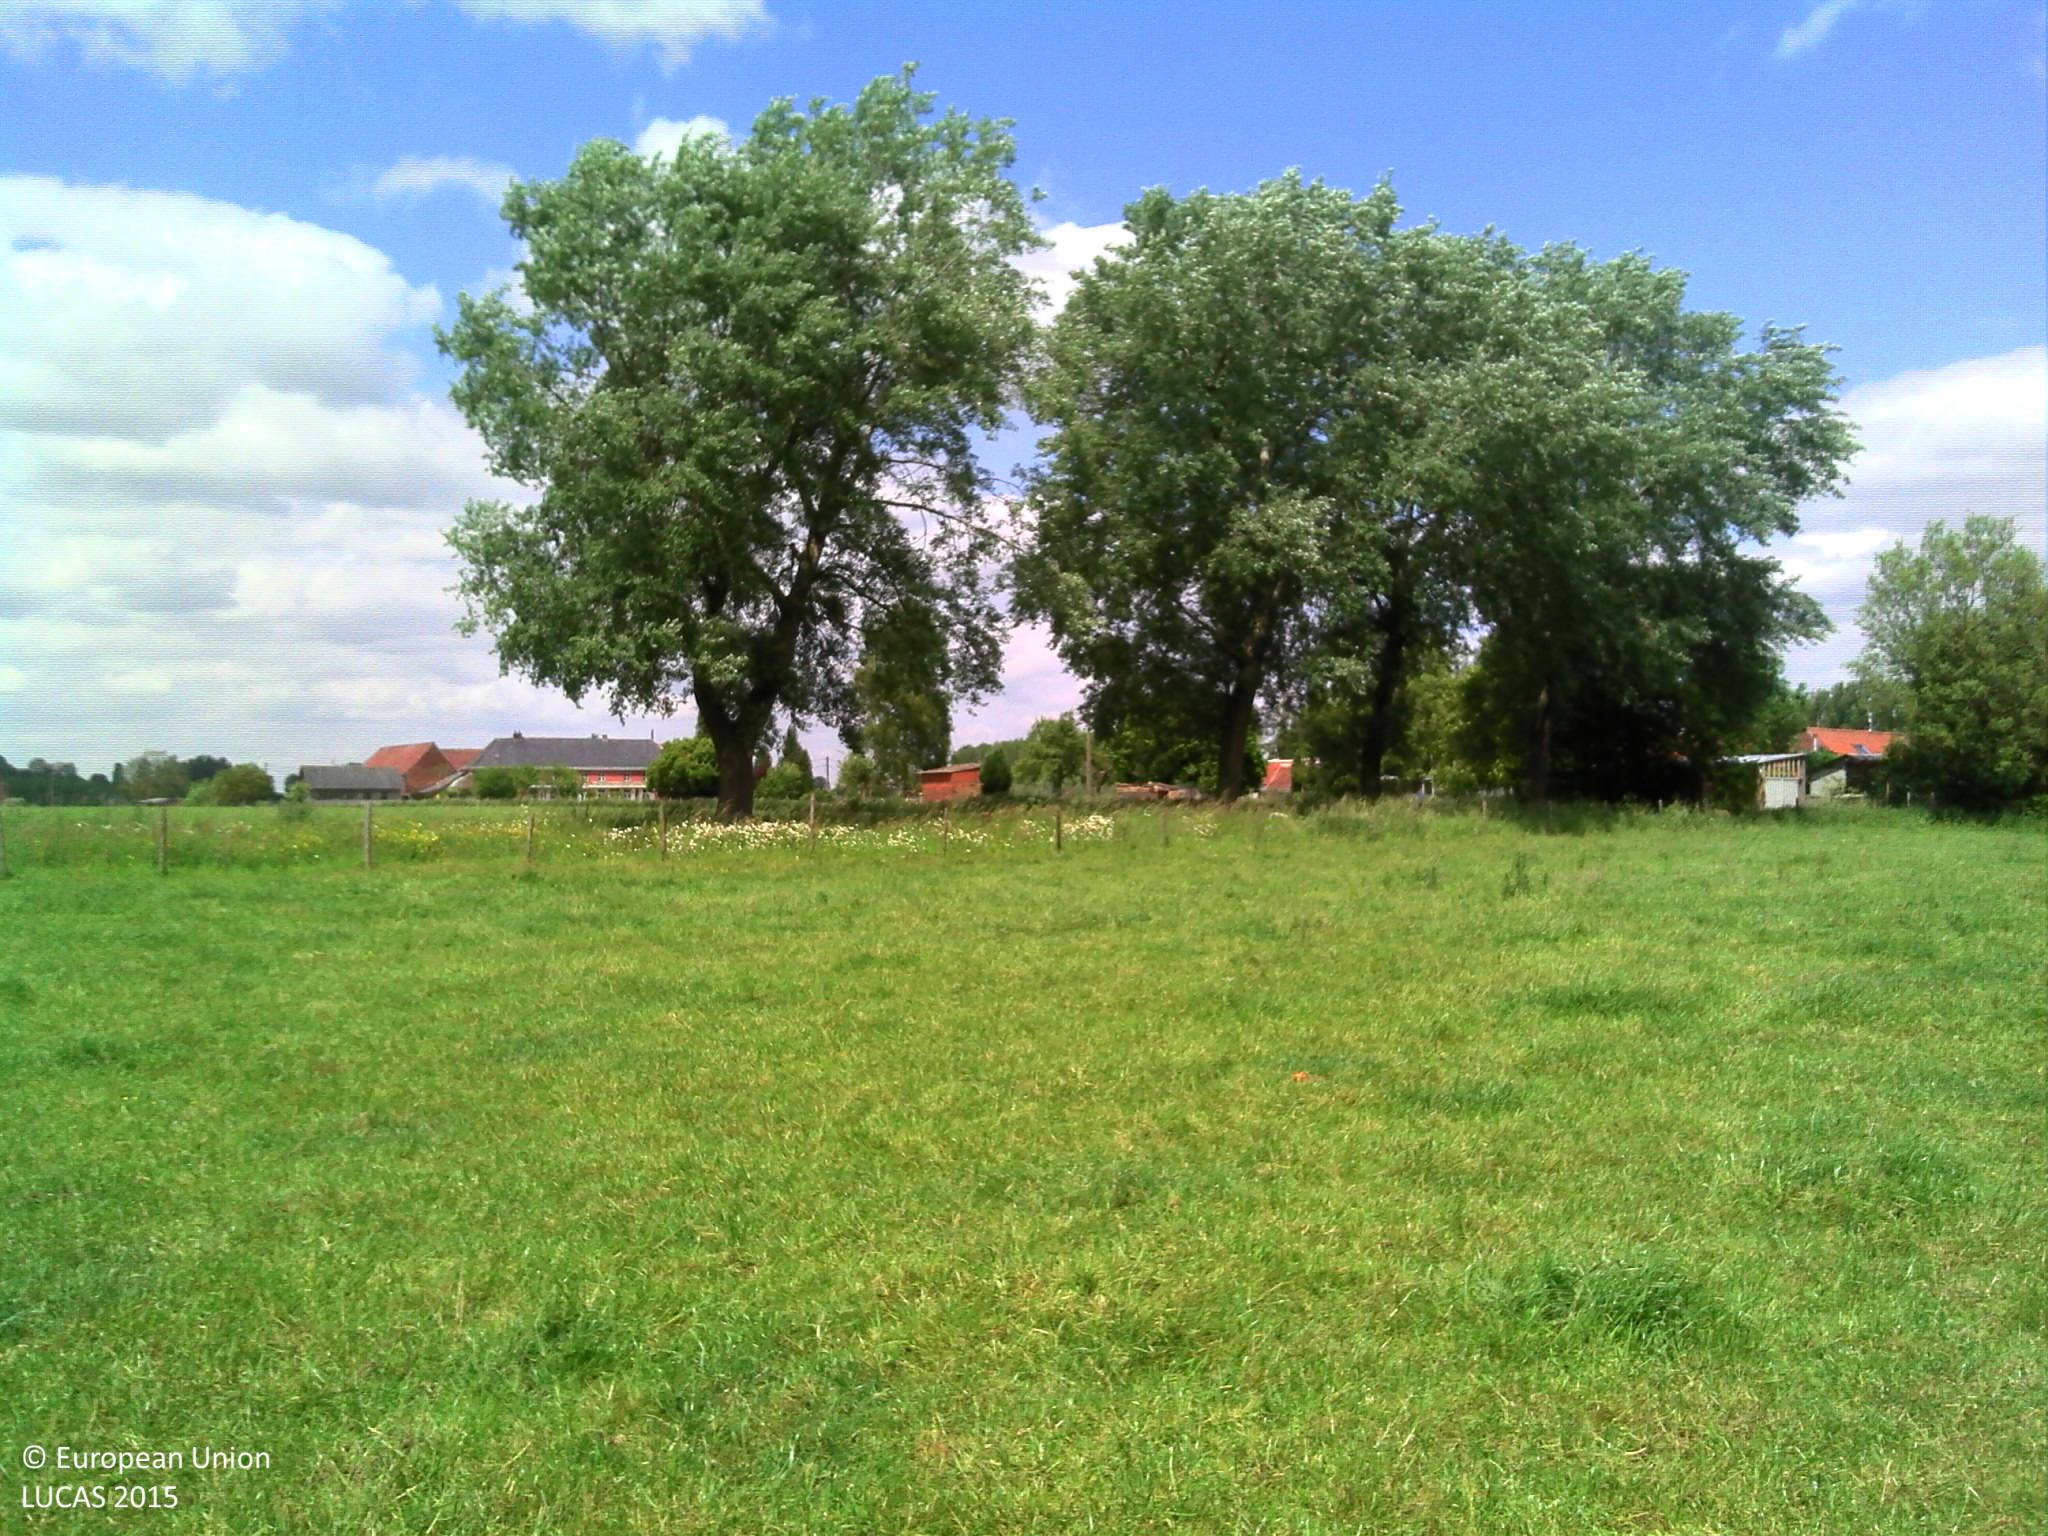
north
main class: Grassland
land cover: Grassland without tree/shrub cover
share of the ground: > 75 %
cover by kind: herbaceous plants 100 %
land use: Agriculture (excluding fallow land and kitchen gardens)
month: June
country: BE
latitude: 50.7907
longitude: 3.7942
